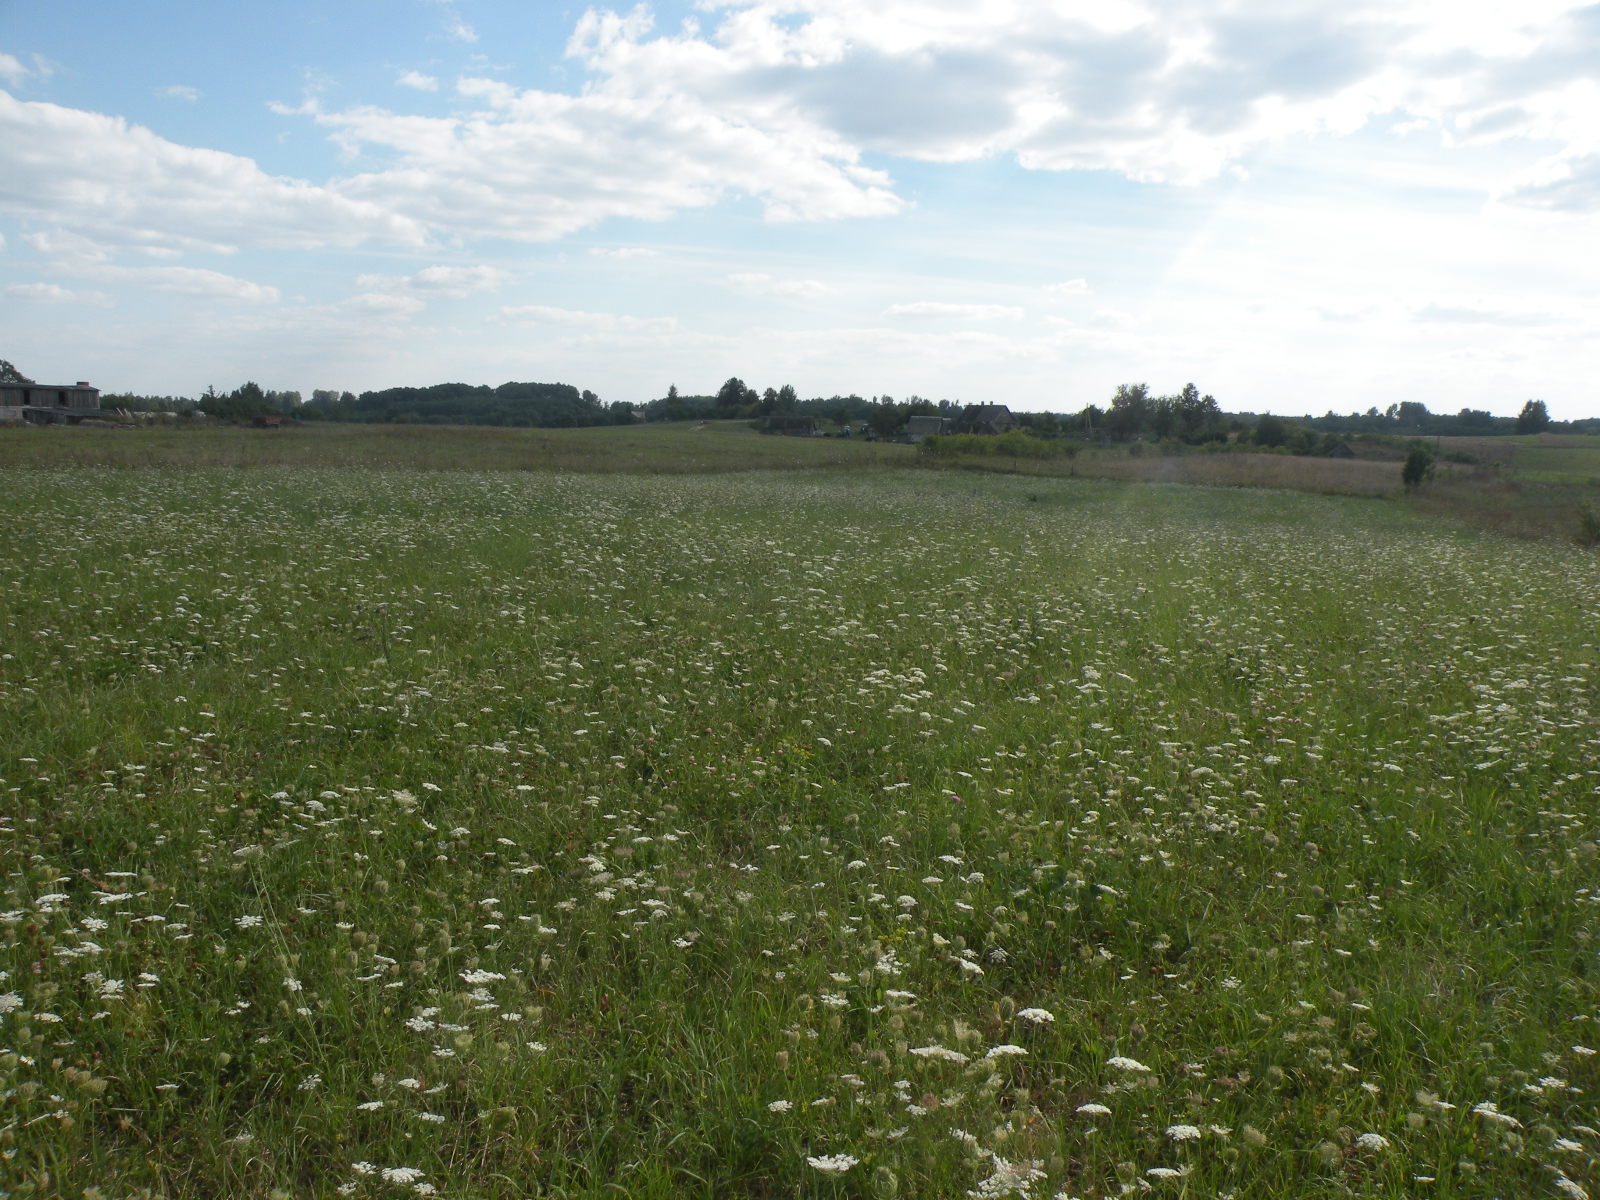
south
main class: Grassland
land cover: Grassland without tree/shrub cover
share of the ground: > 75 %
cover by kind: herbaceous plants 95 %, unconsolidated bare surface 5 %
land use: Agriculture (excluding fallow land and kitchen gardens)
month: August
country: LV
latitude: 55.7290
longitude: 26.5375
